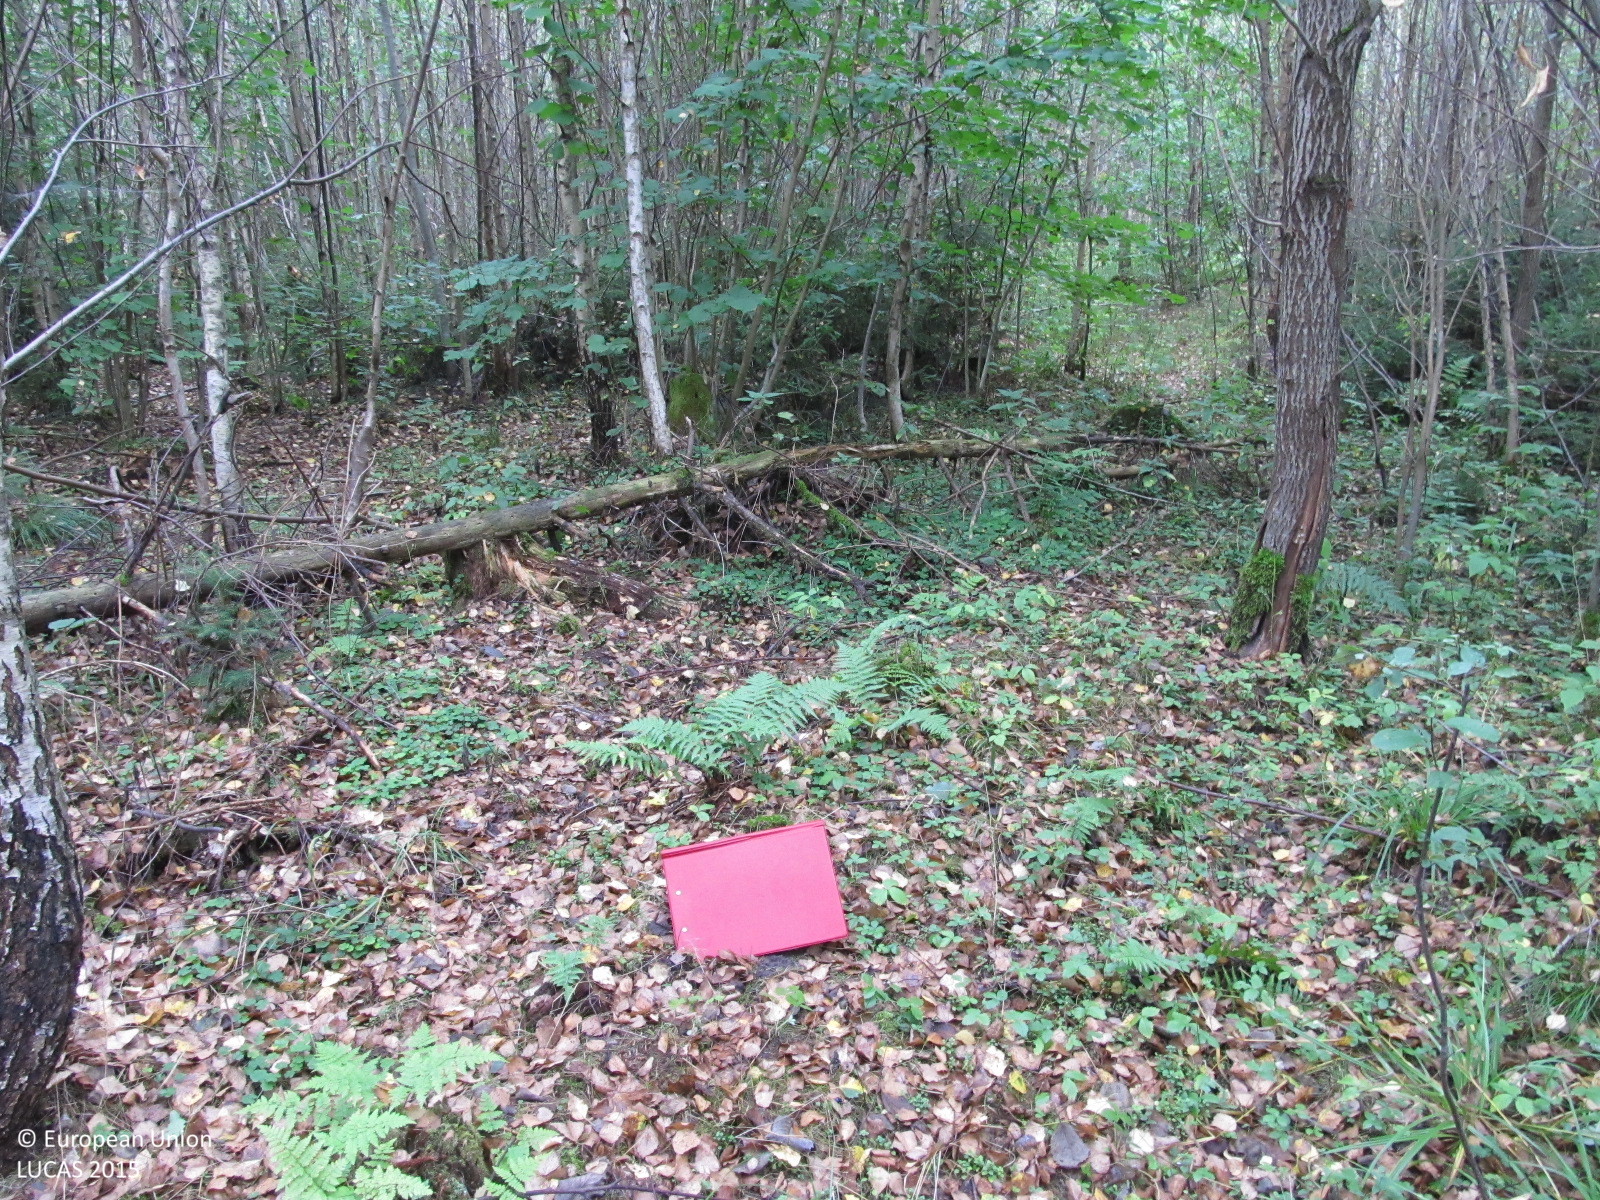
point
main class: Woodland
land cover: Broadleaved woodland
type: non-riverine alder, birch or aspen forest
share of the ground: > 75 %
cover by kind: broadleaved forest trees 70 %, coniferous forest trees 10 %, herbaceous plants 10 %, shrubs 5 %, unconsolidated bare surface 5 %
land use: Forestry
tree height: > 5 m
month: September
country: LT
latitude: 56.0502
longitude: 22.4695
